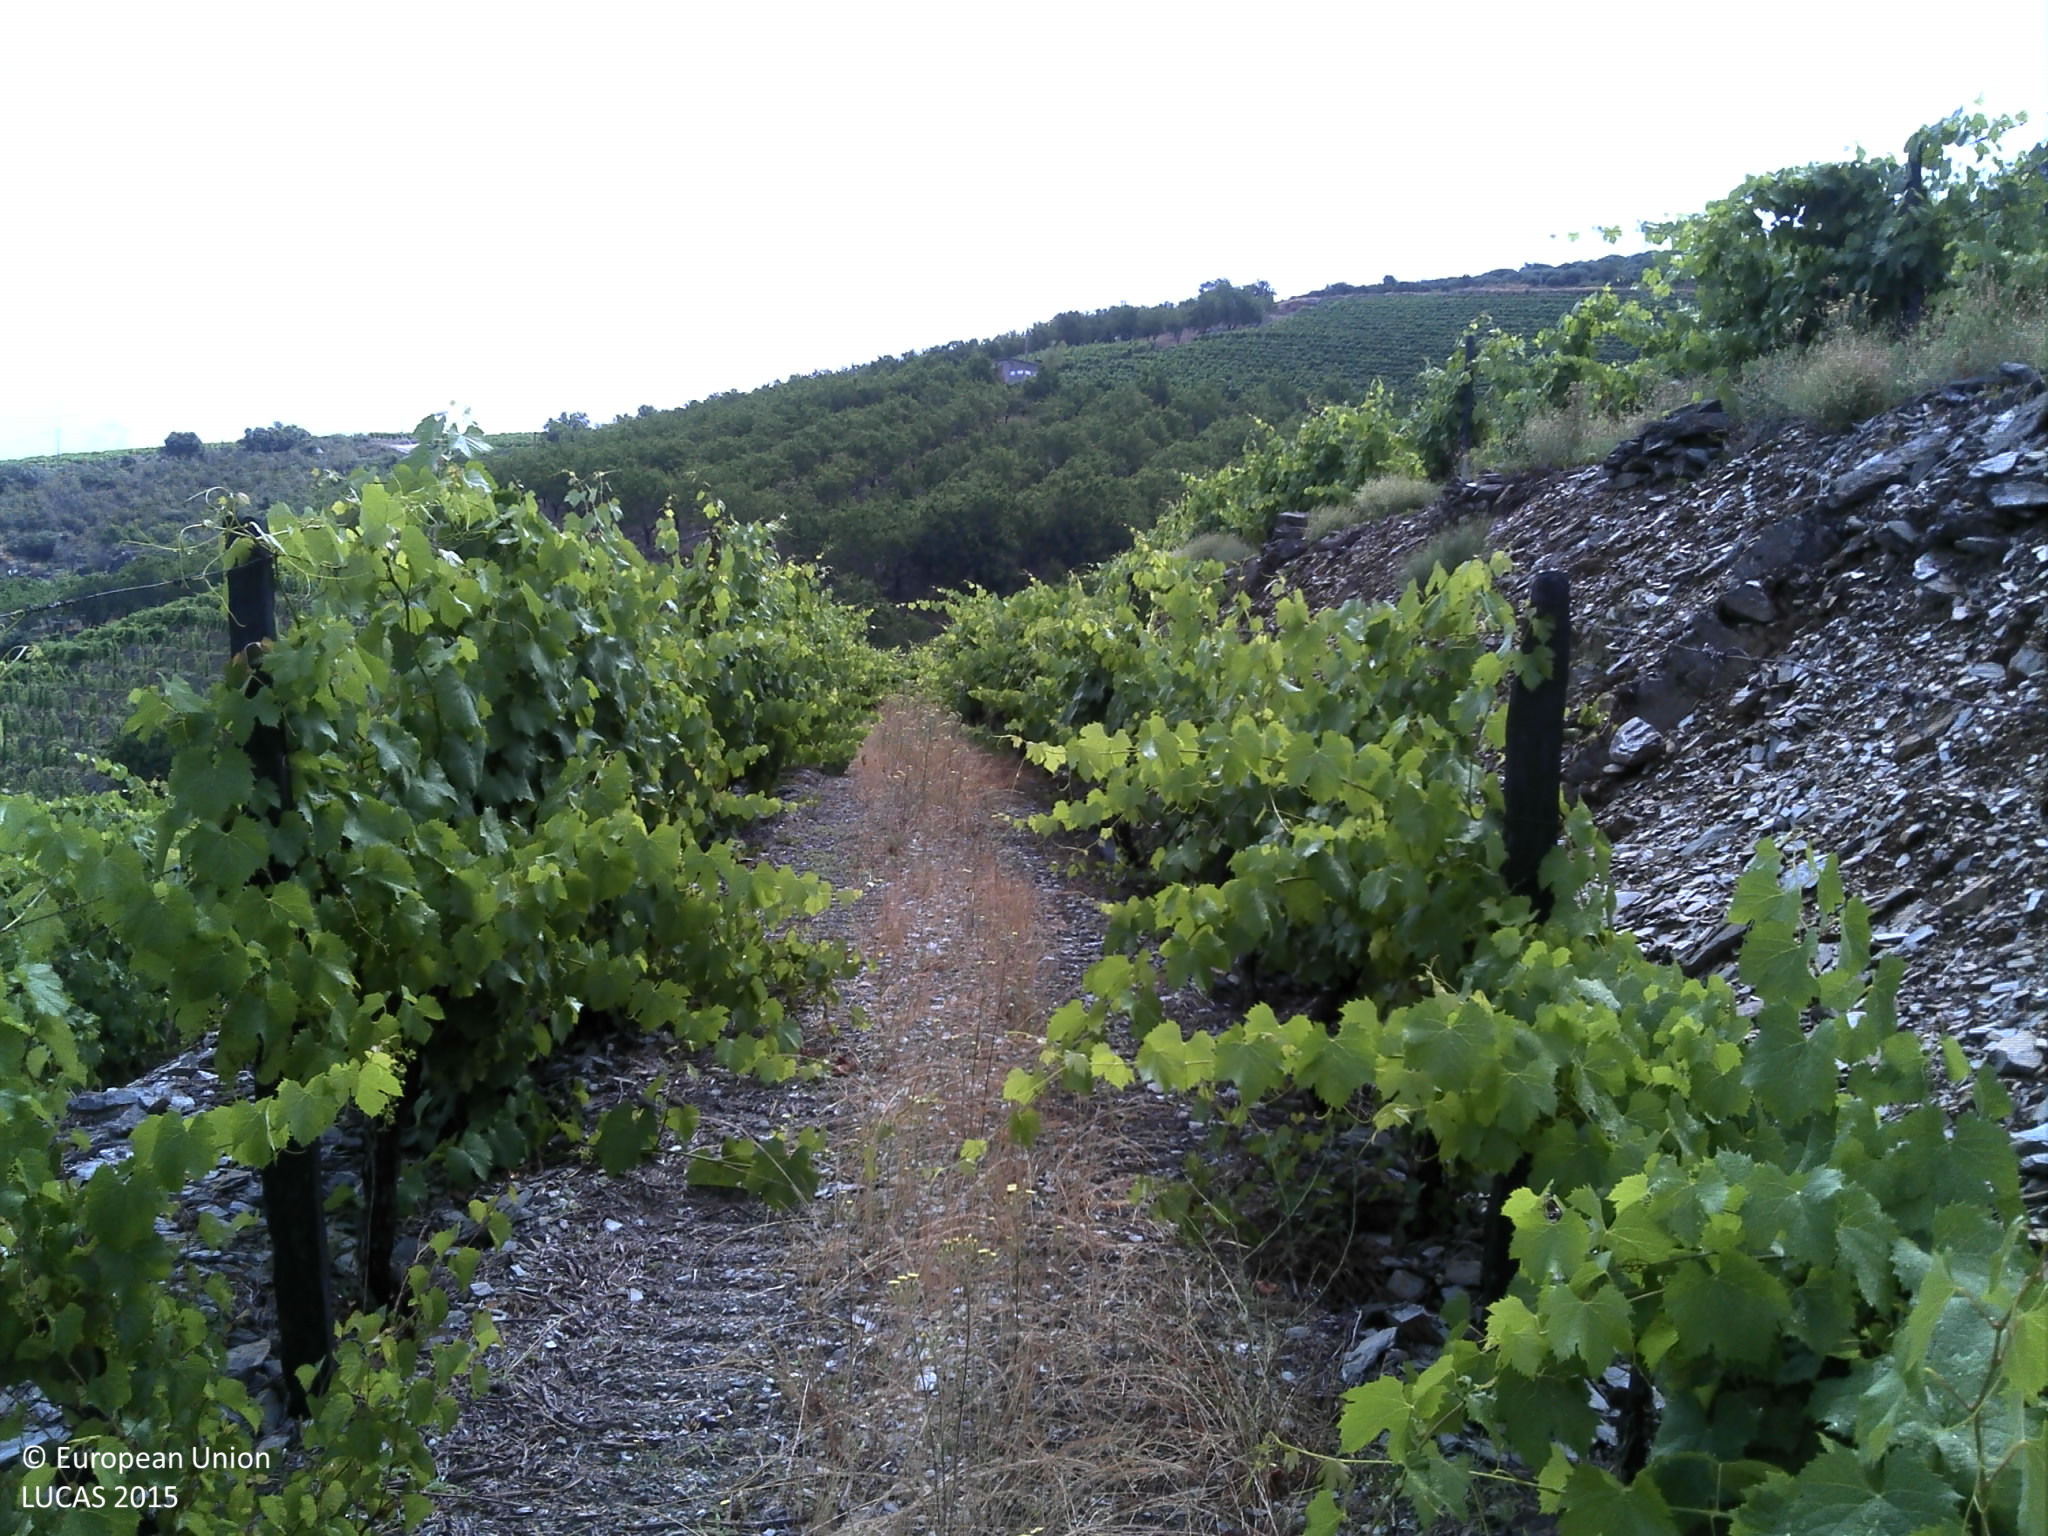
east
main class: Cropland
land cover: Vineyards
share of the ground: < 10 %
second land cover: Spontaneously vegetated surfaces
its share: 10 - 25 %
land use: Agriculture (excluding fallow land and kitchen gardens)
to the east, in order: Vineyards; Spontaneously vegetated surfaces; Tracks; Vineyards; Electric lines; Ditches and canals; Nuts trees; Tracks; Nuts trees; Tracks; Vineyards; Tracks; Vineyards; Artificial constructions in urban areas; Vineyards
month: June
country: PT
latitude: 41.1686
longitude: -7.4141
